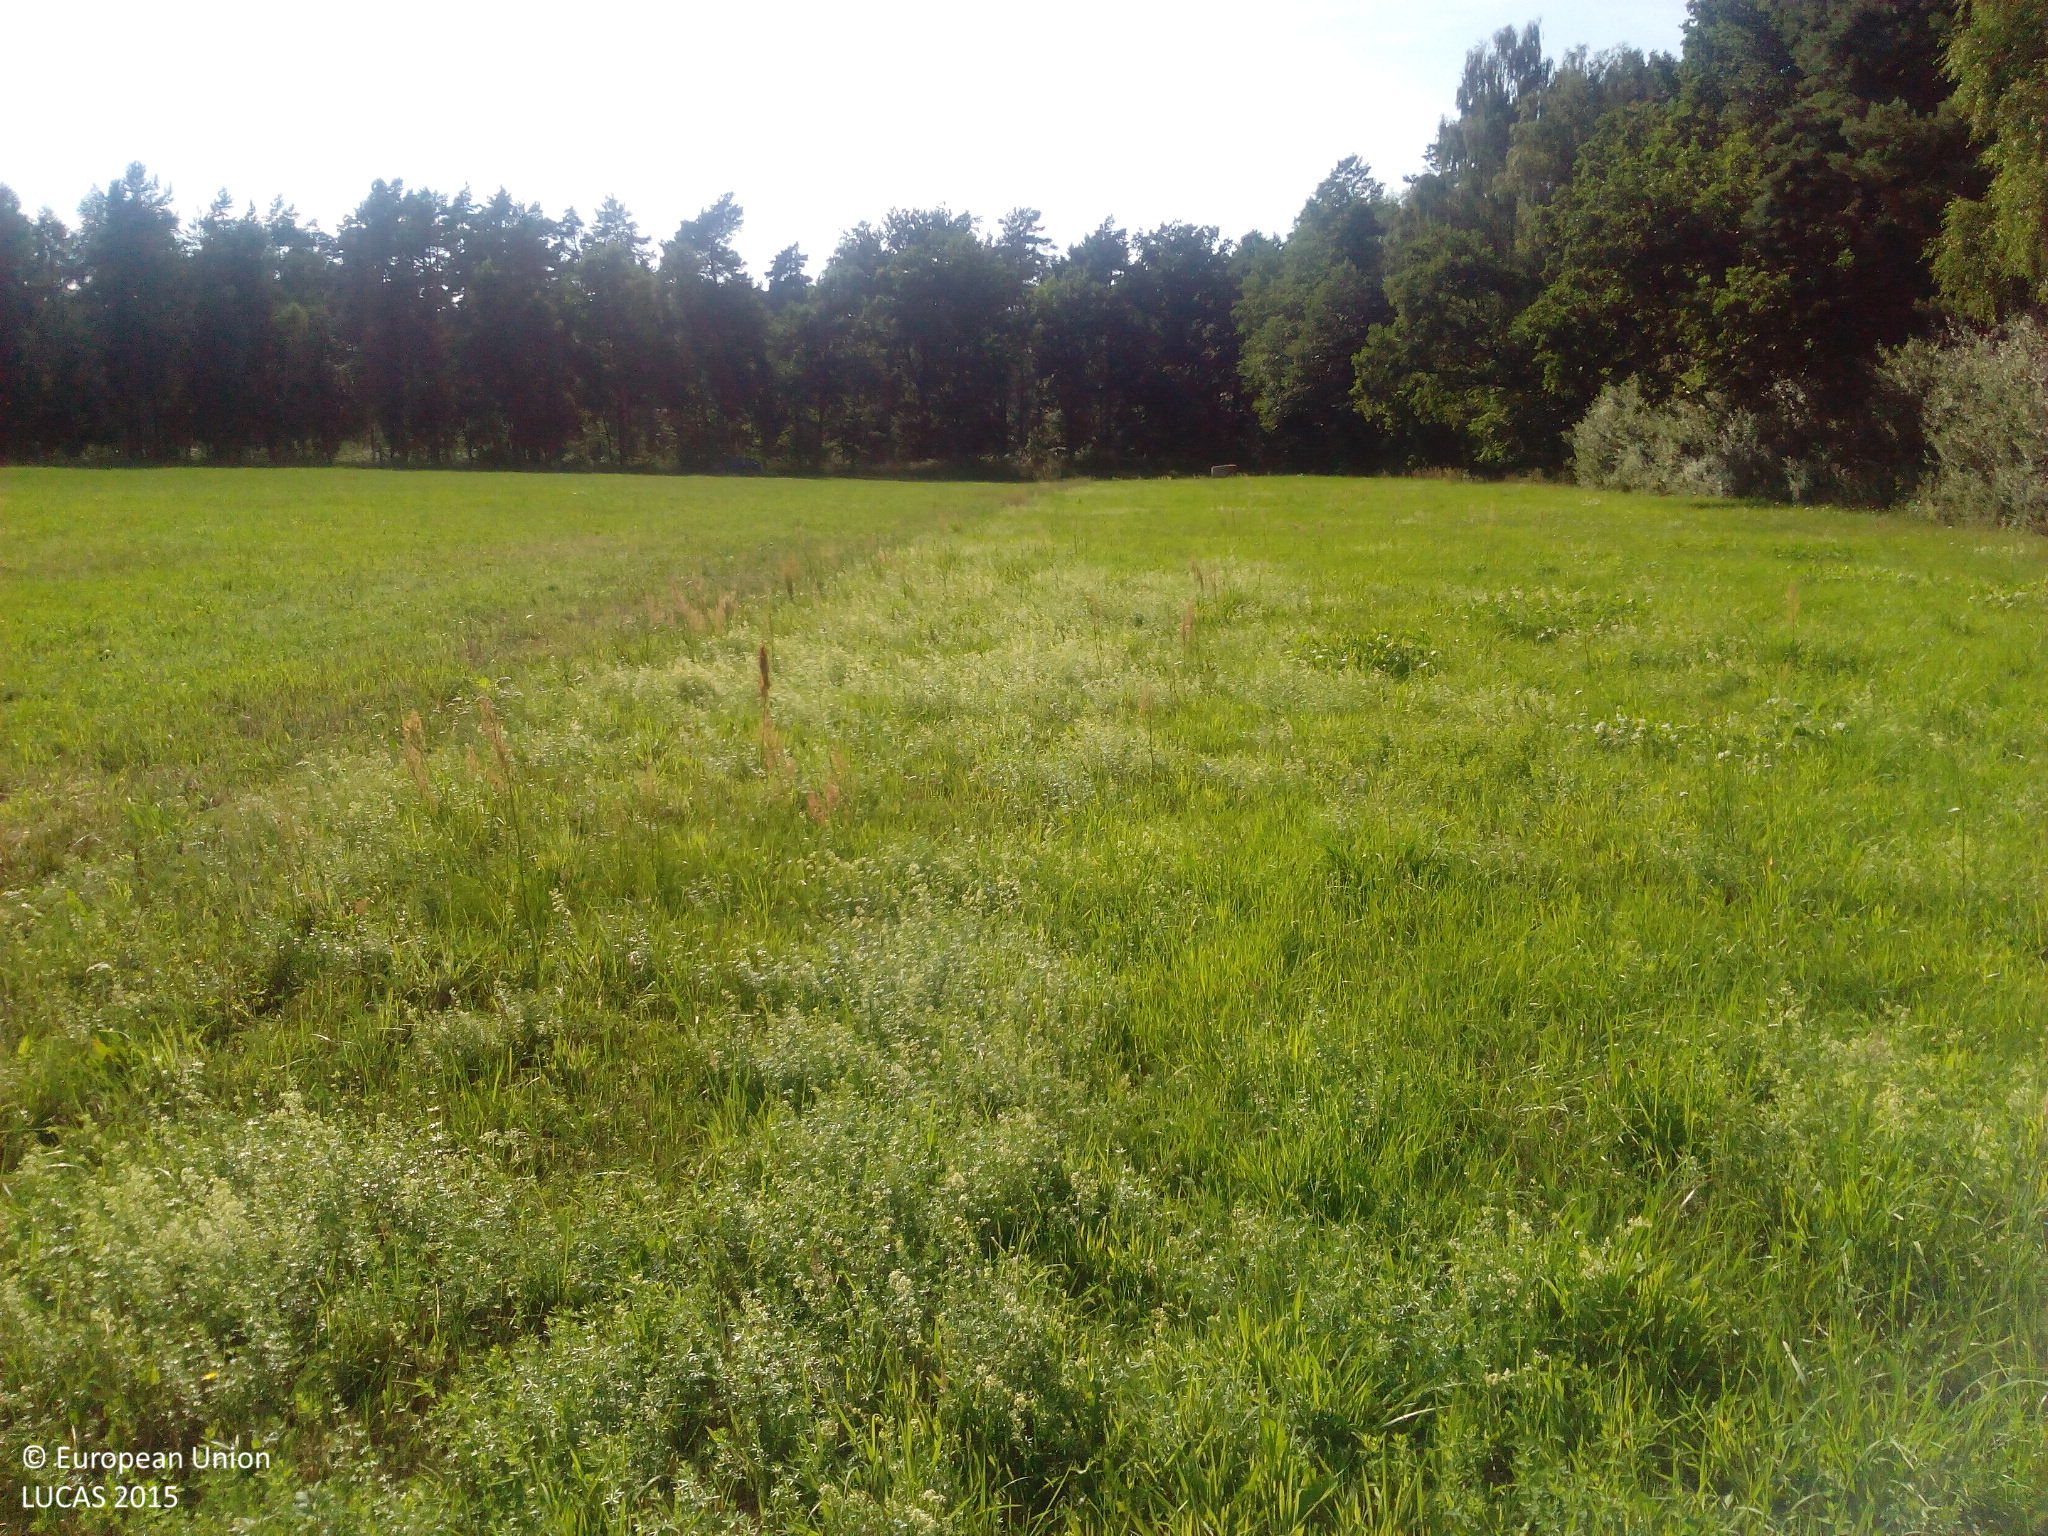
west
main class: Grassland
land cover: Grassland without tree/shrub cover
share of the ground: > 75 %
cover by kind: herbaceous plants 100 %
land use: Agriculture (excluding fallow land and kitchen gardens)
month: July
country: DE
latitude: 51.9576
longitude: 12.4008
